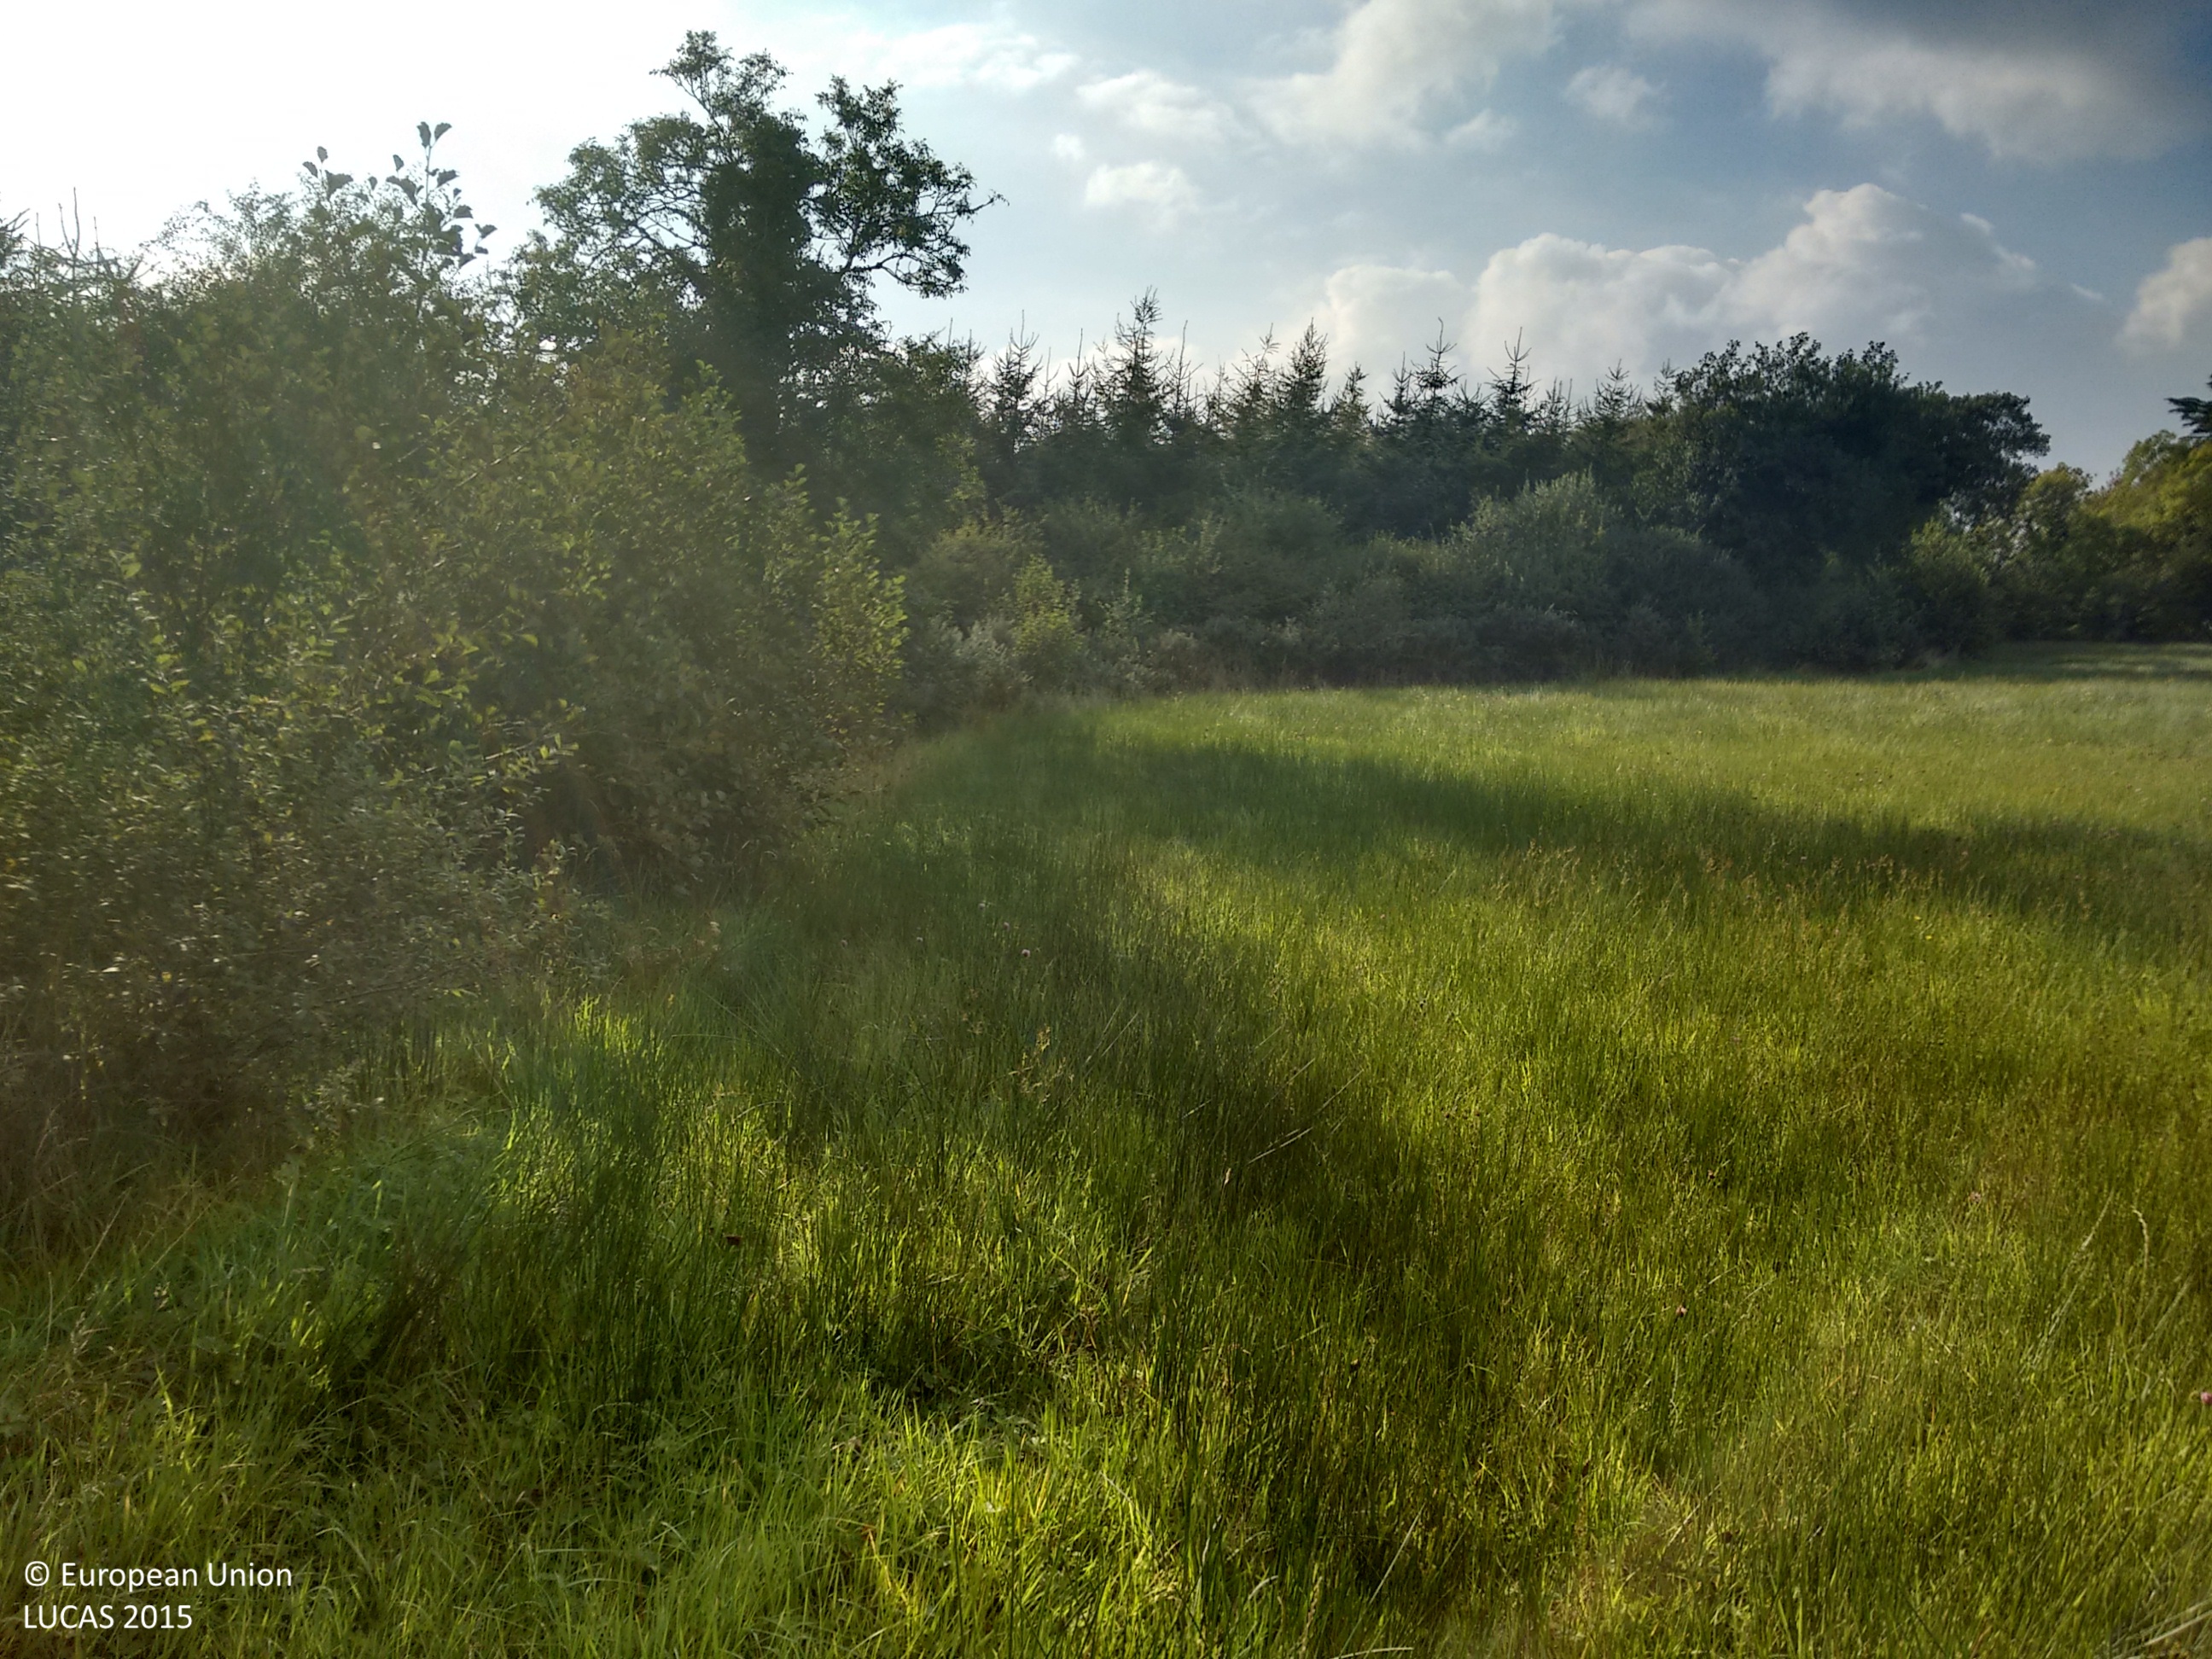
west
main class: Grassland
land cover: Grassland without tree/shrub cover
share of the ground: > 75 %
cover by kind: herbaceous plants 75 %, shrubs 5 %
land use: Agriculture (excluding fallow land and kitchen gardens)
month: September
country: IE
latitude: 52.5469
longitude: -9.1997
